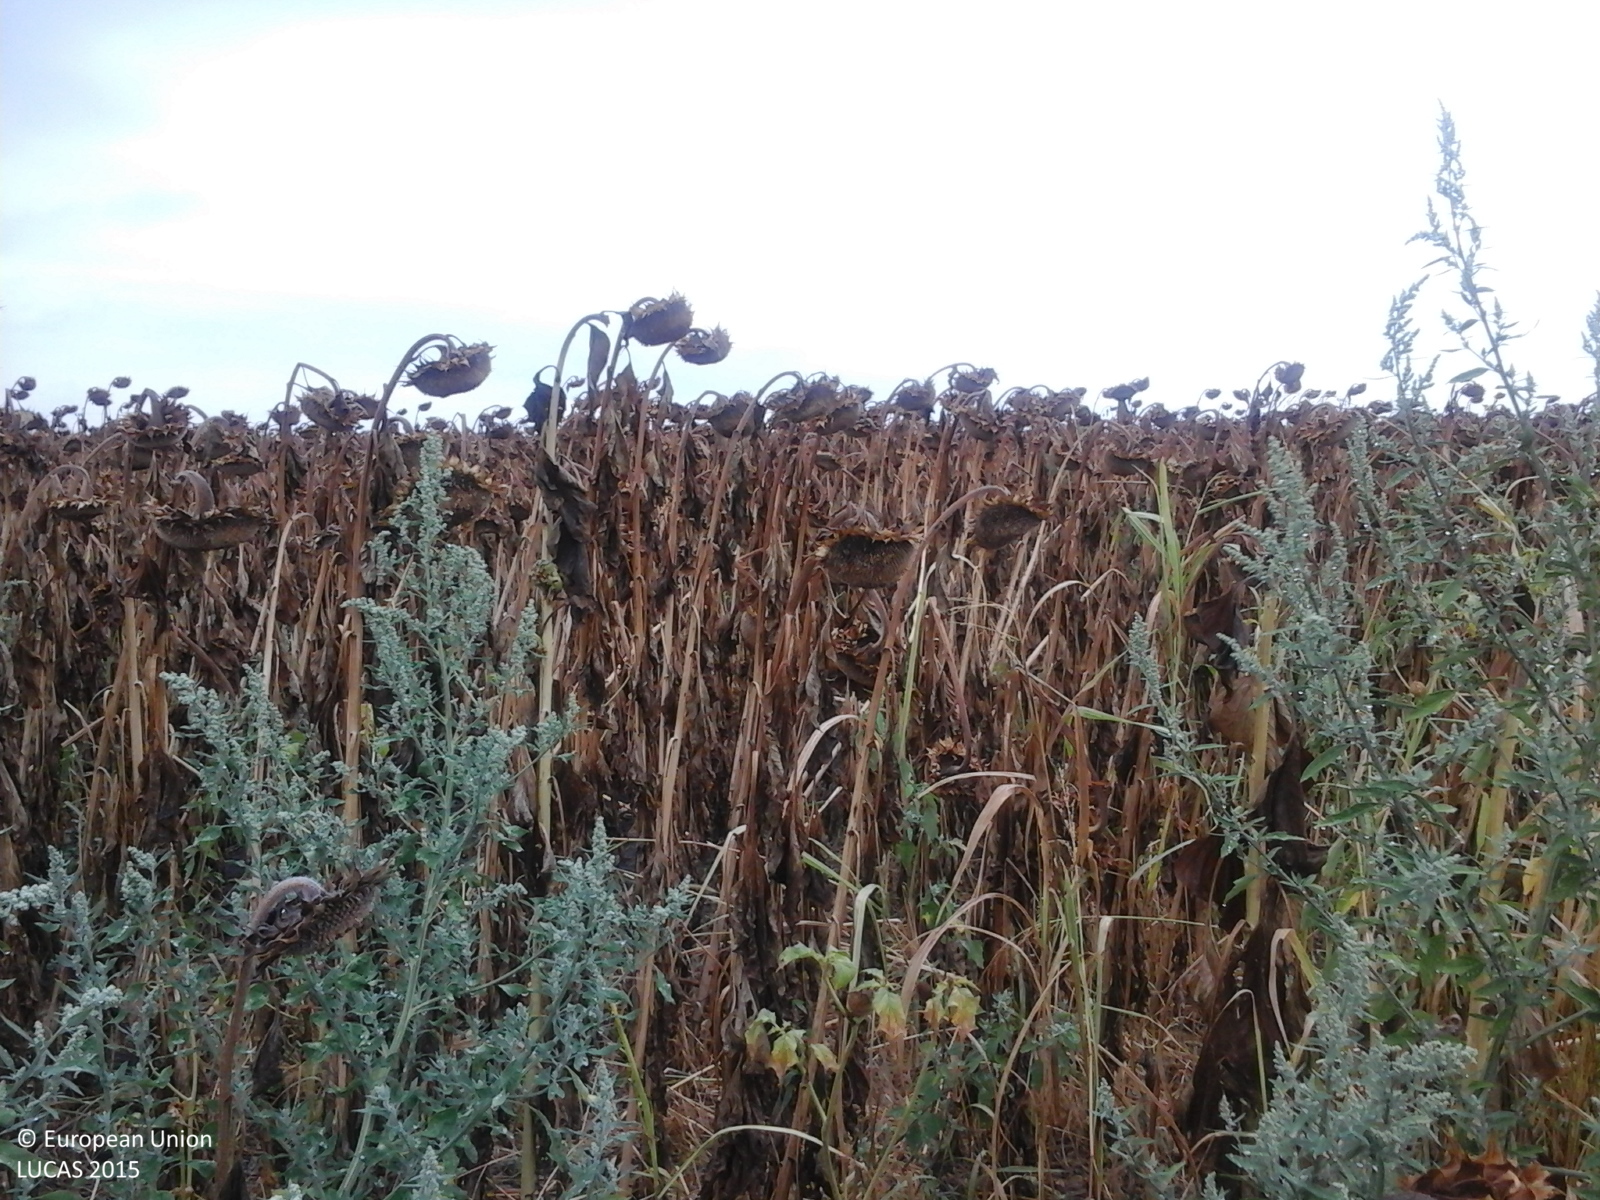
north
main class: Cropland
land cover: Sunflower
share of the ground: > 75 %
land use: Agriculture (excluding fallow land and kitchen gardens)
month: August
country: RO
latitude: 45.9738
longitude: 20.7256
